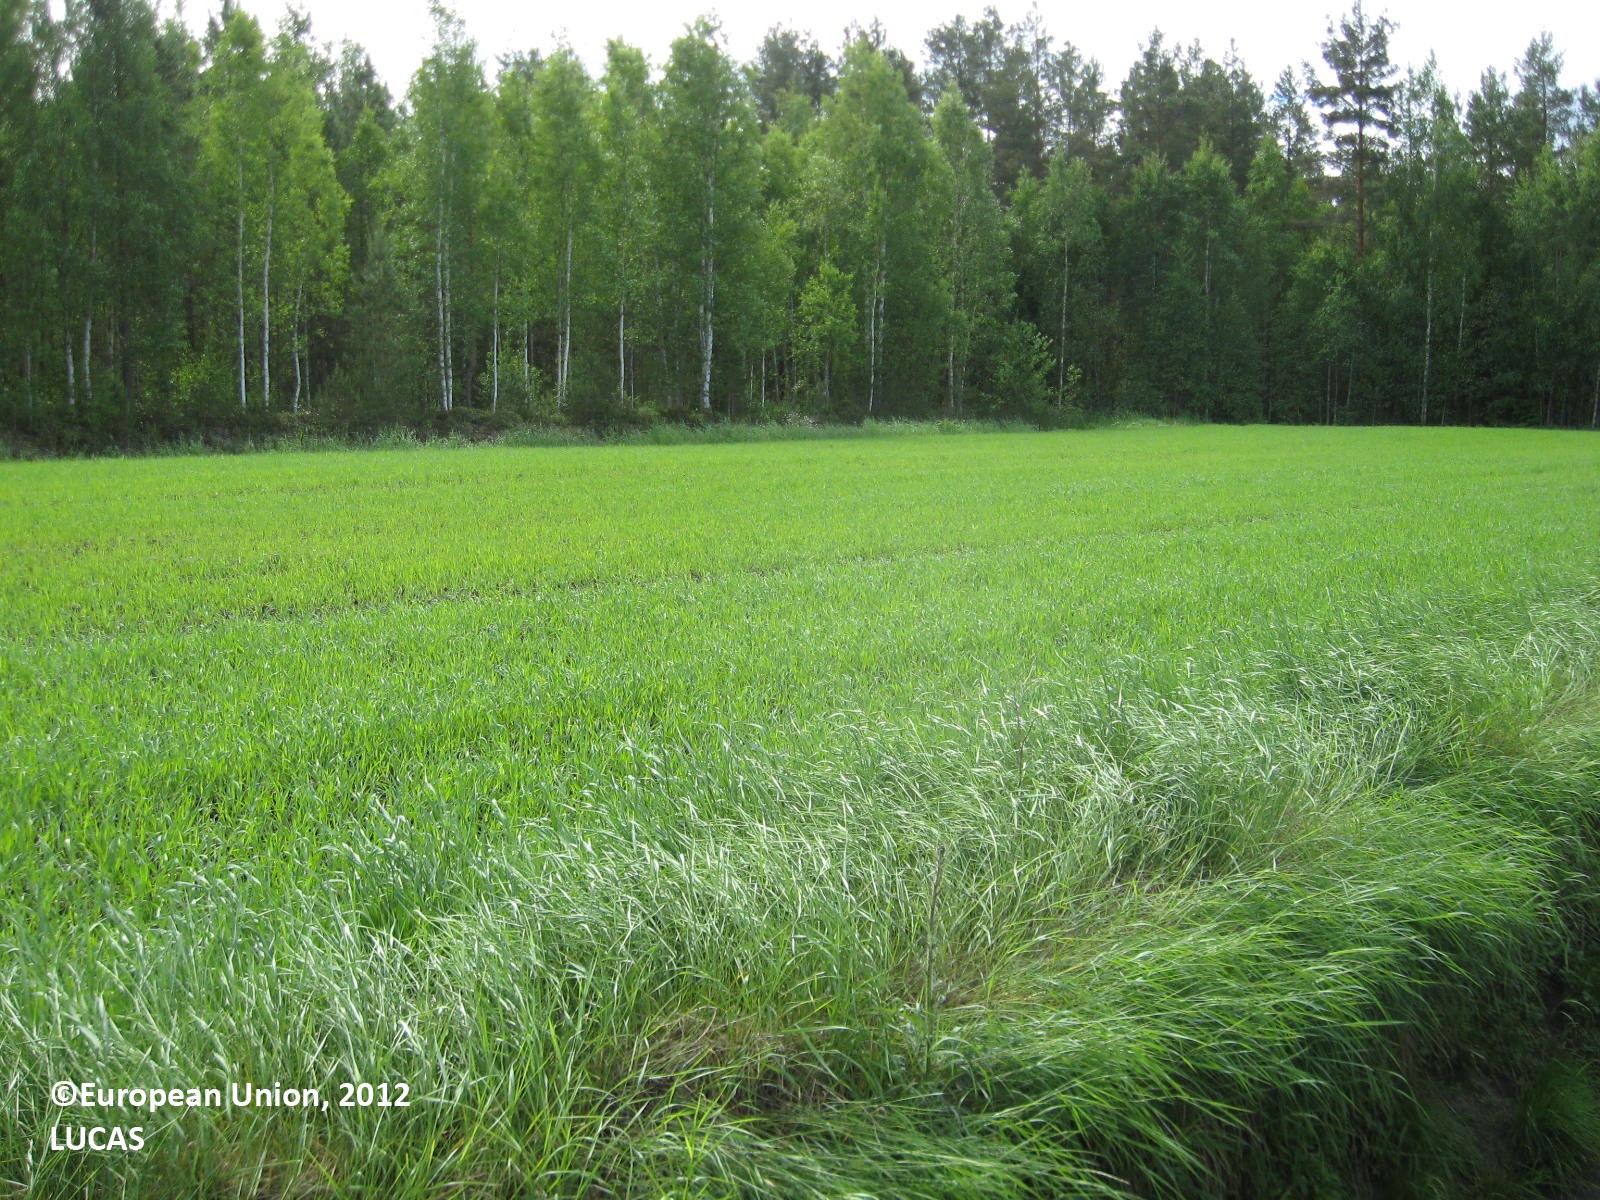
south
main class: Cropland
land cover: Barley
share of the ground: > 75 %
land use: Agriculture (excluding fallow land and kitchen gardens)
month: June
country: FI
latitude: 62.8168
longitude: 22.5523
